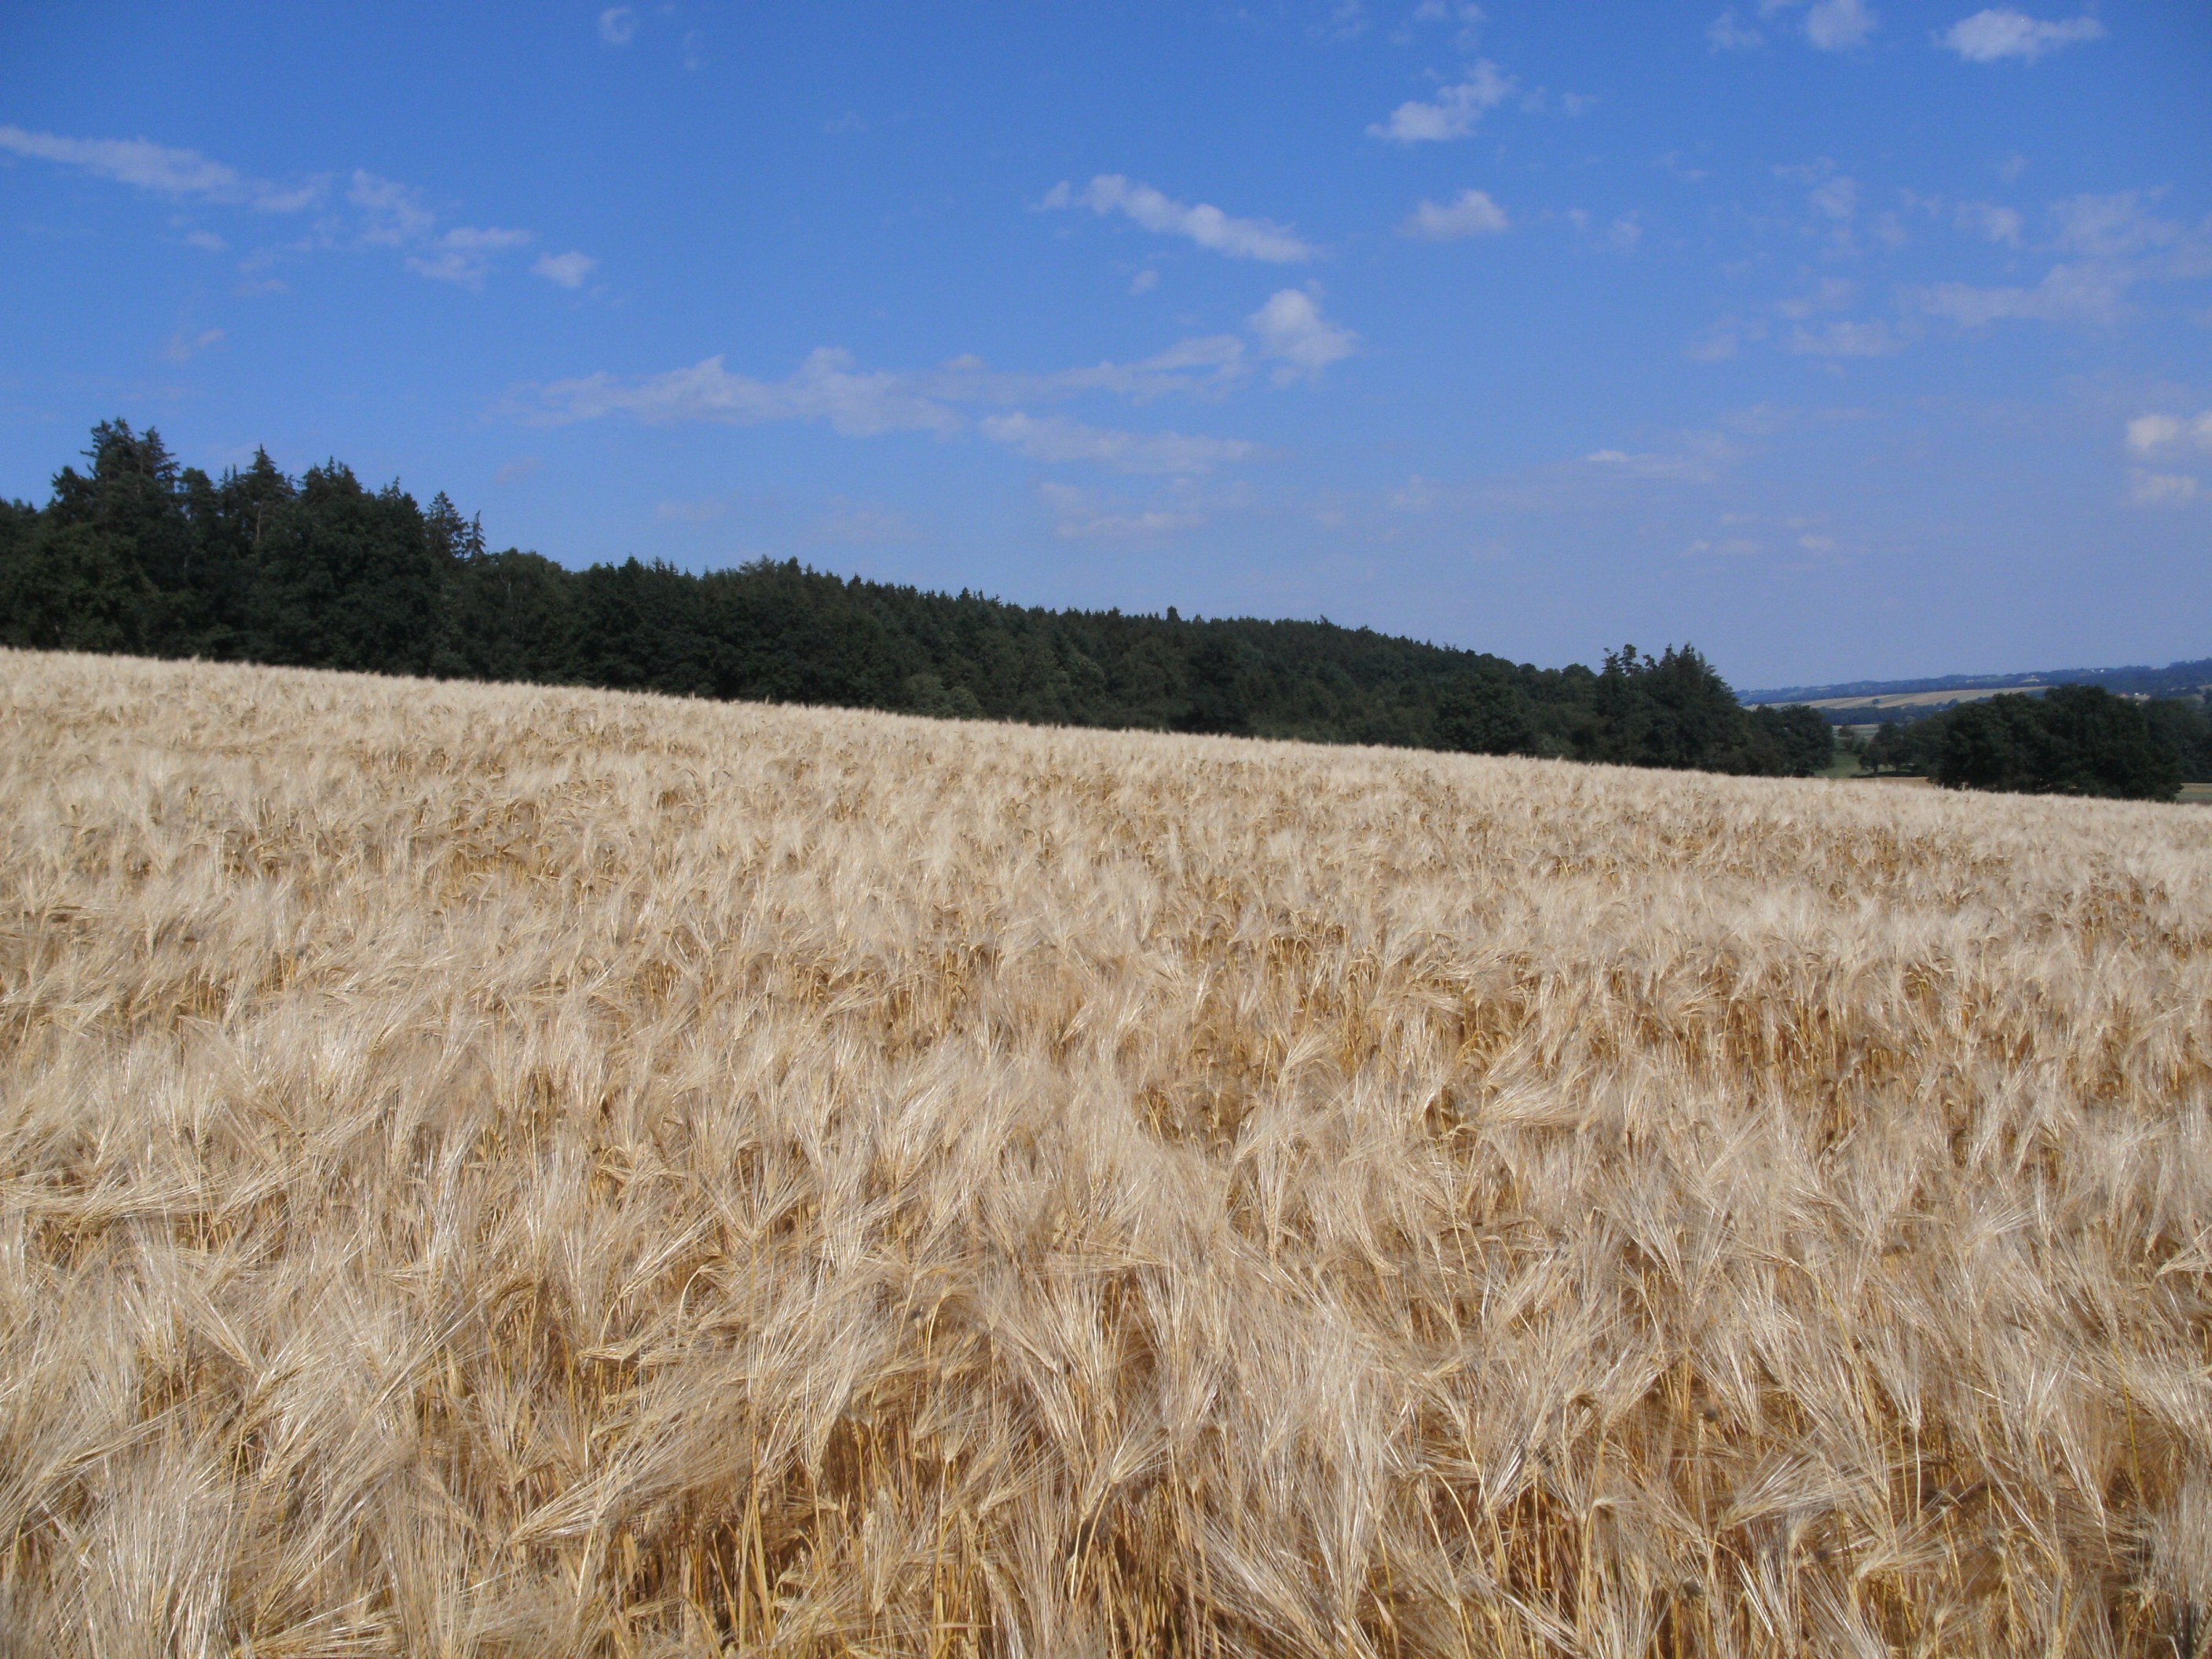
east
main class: Cropland
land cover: Barley
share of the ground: > 75 %
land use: Agriculture (excluding fallow land and kitchen gardens)
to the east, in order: Barley; Grass margins; Tracks; Grass margins; Maize
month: June
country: AT
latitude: 48.2505
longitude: 13.7301
